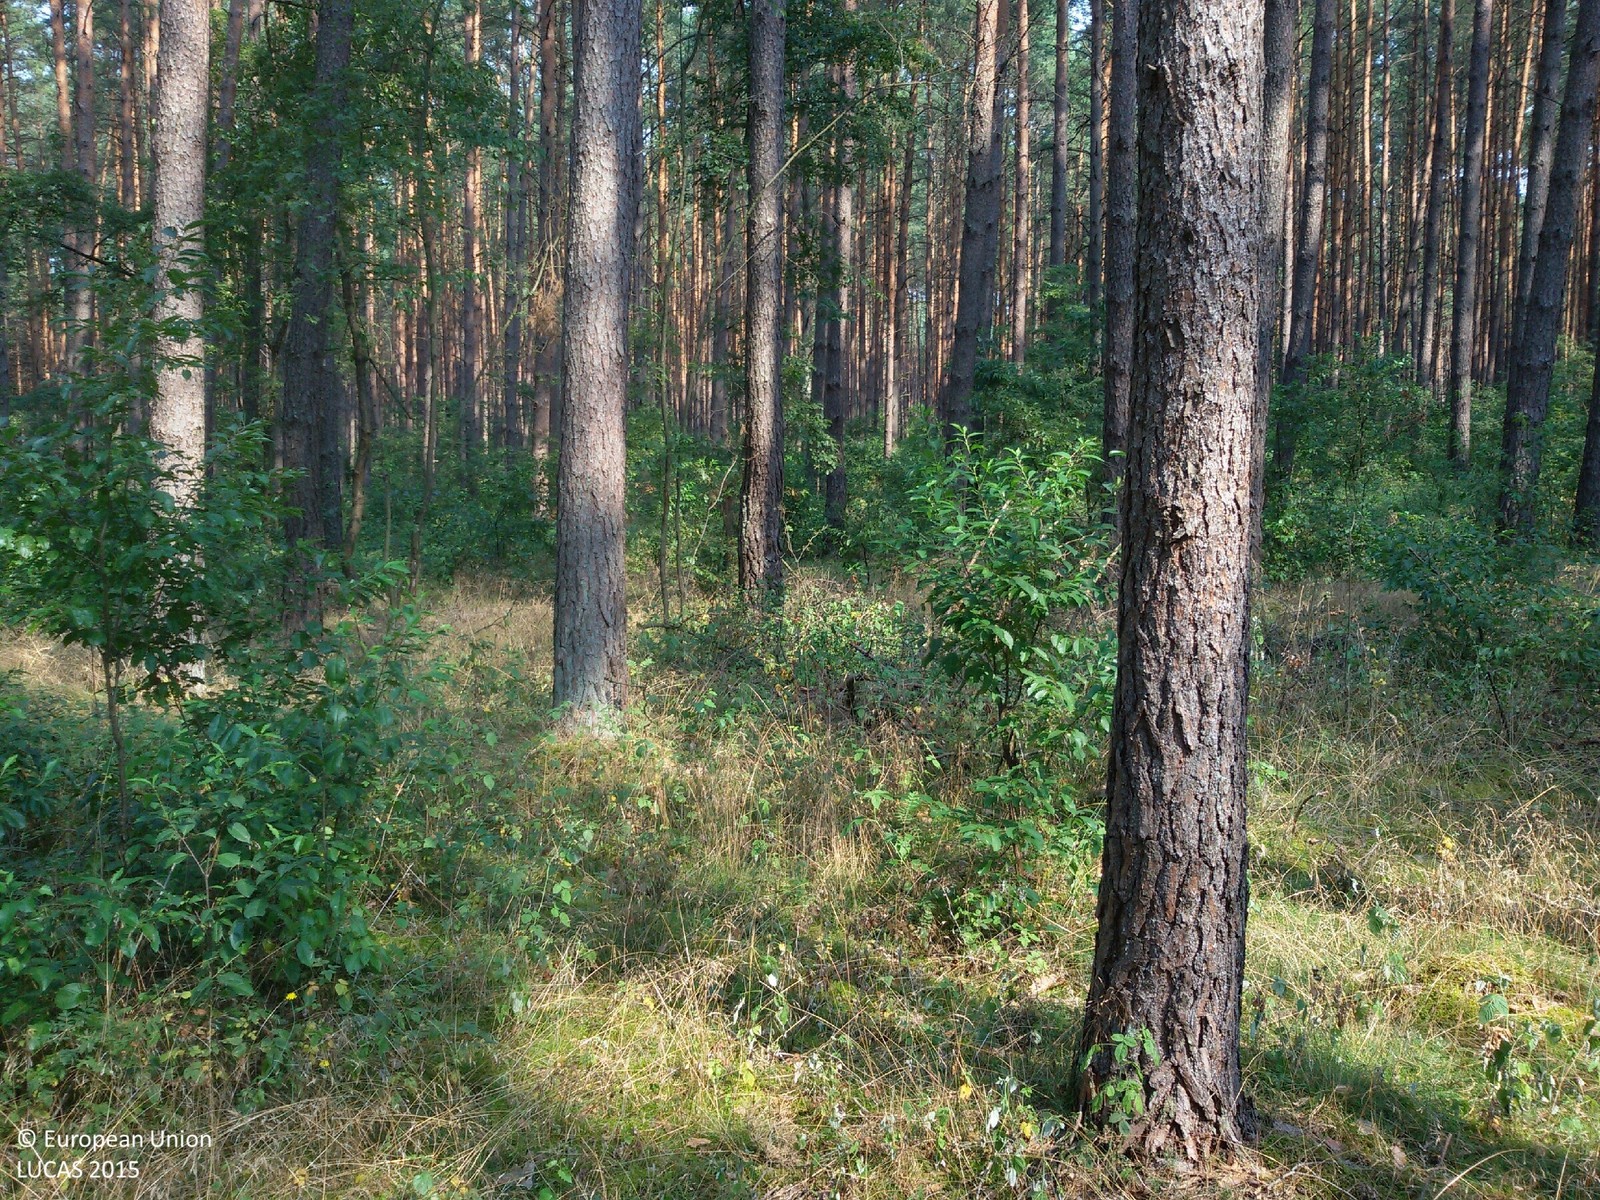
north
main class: Woodland
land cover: Pine dominated coniferous woodland
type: hemiboreal forest and nemoral coniferous forest and mixed broadleaved-coniferous forest
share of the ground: > 75 %
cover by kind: coniferous forest trees 90 %, shrubs 5 %, herbaceous plants 5 %
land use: Forestry
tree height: > 5 m
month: August
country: PL
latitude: 52.8301
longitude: 14.5581
